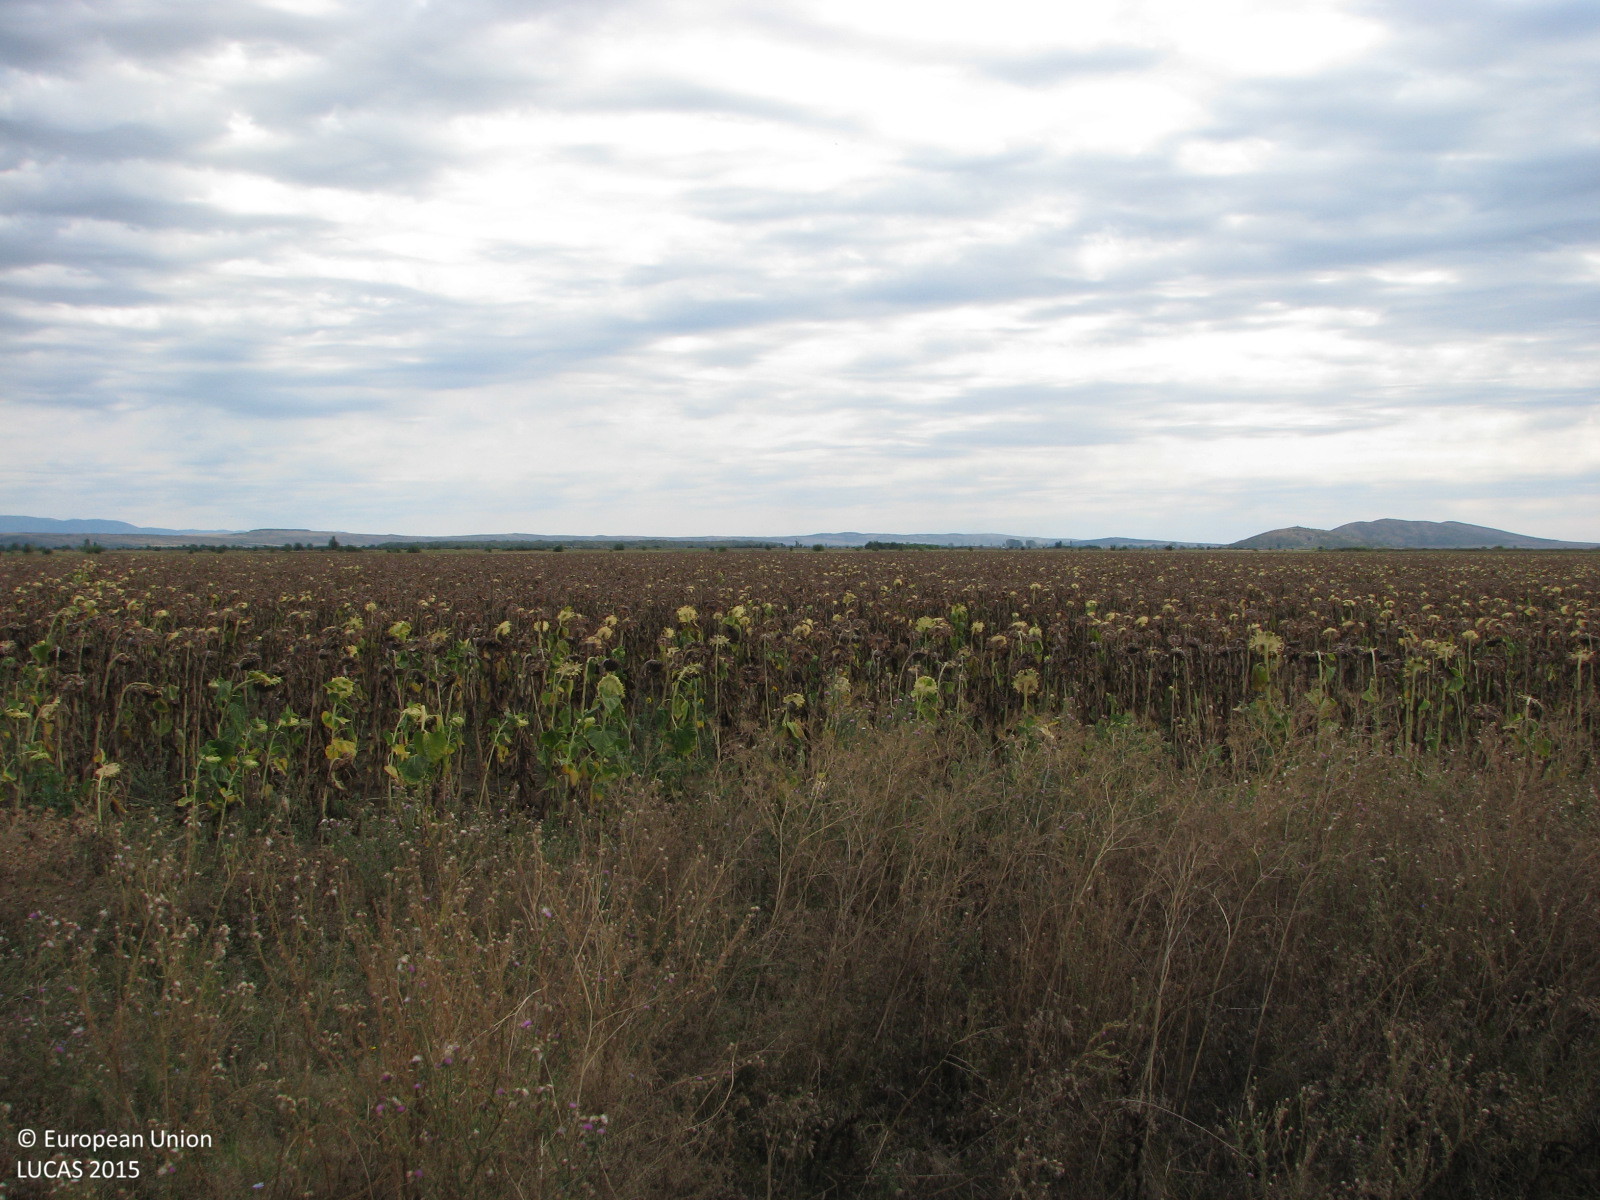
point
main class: Cropland
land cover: Sunflower
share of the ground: > 75 %
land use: Agriculture (excluding fallow land and kitchen gardens)
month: September
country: BG
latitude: 42.5157
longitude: 26.0886
